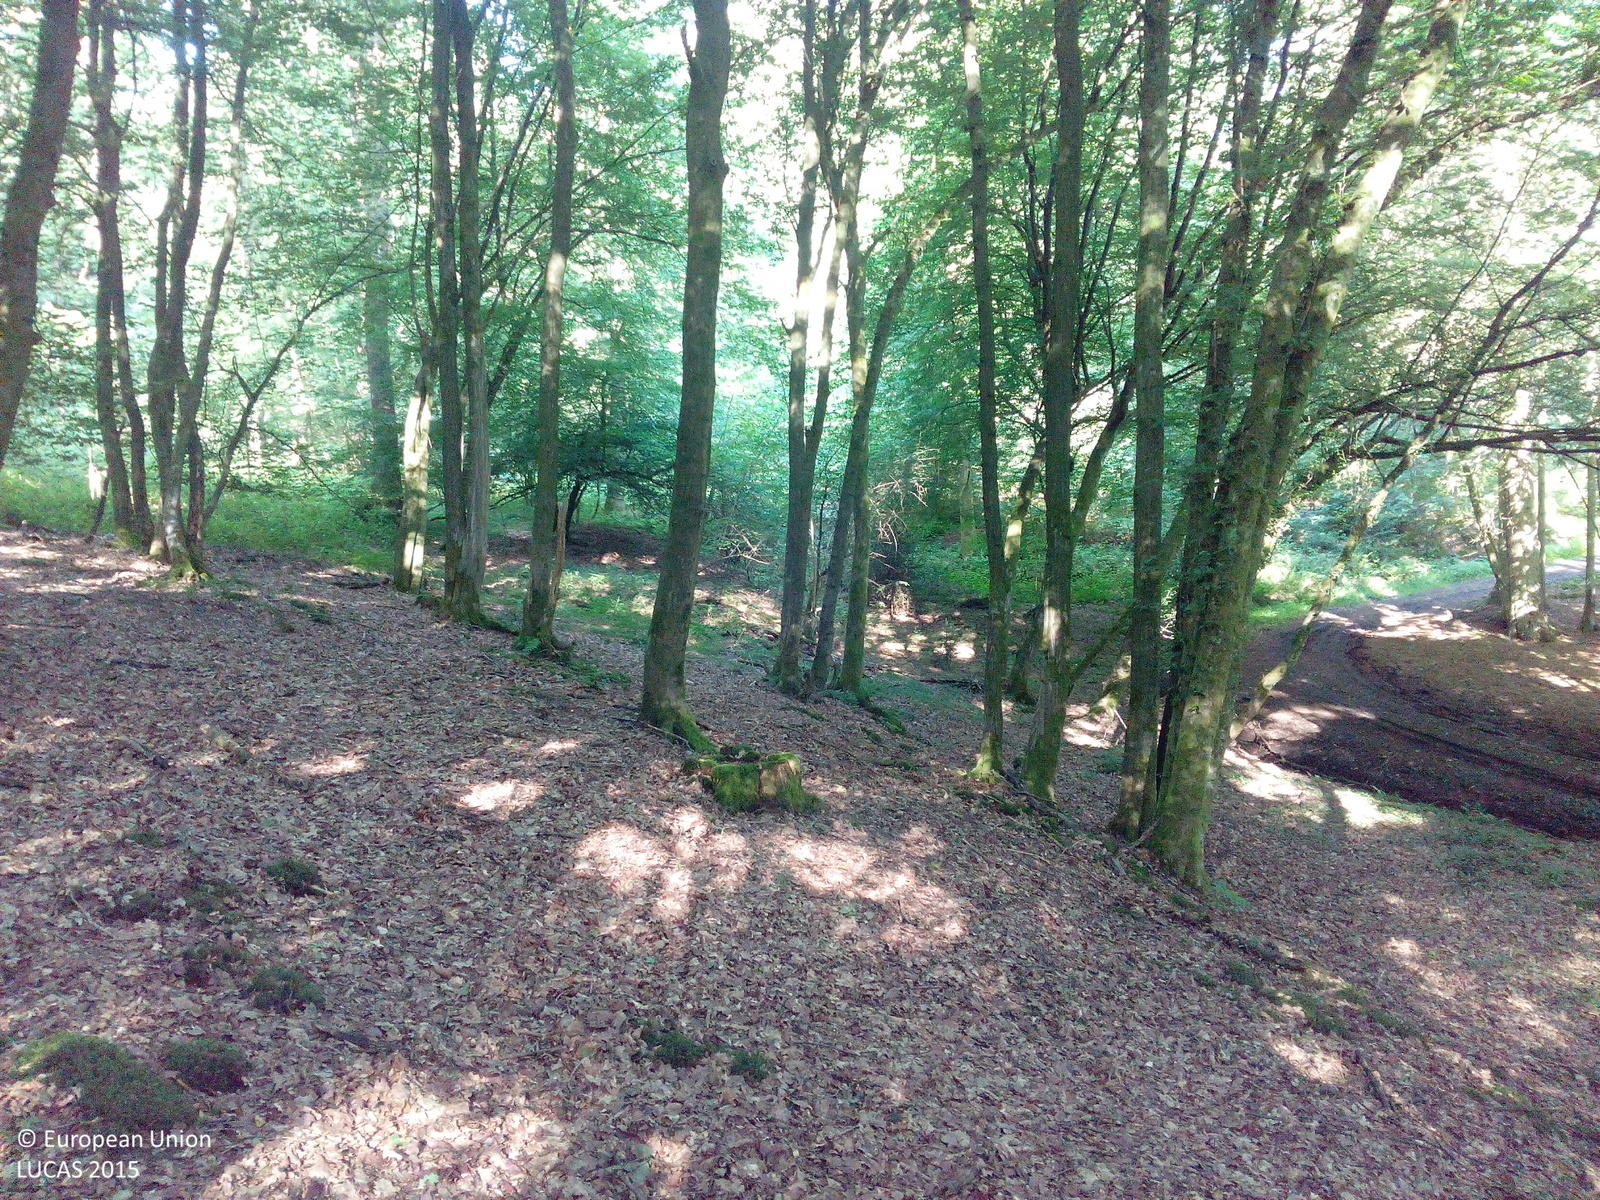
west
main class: Woodland
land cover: Broadleaved woodland
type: mesophytic deciduous forest
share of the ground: > 75 %
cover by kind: broadleaved forest trees 85 %, coniferous forest trees 15 %
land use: Forestry
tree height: > 5 m
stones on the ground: < 10 %
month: June
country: DE
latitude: 50.8748
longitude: 7.4279
